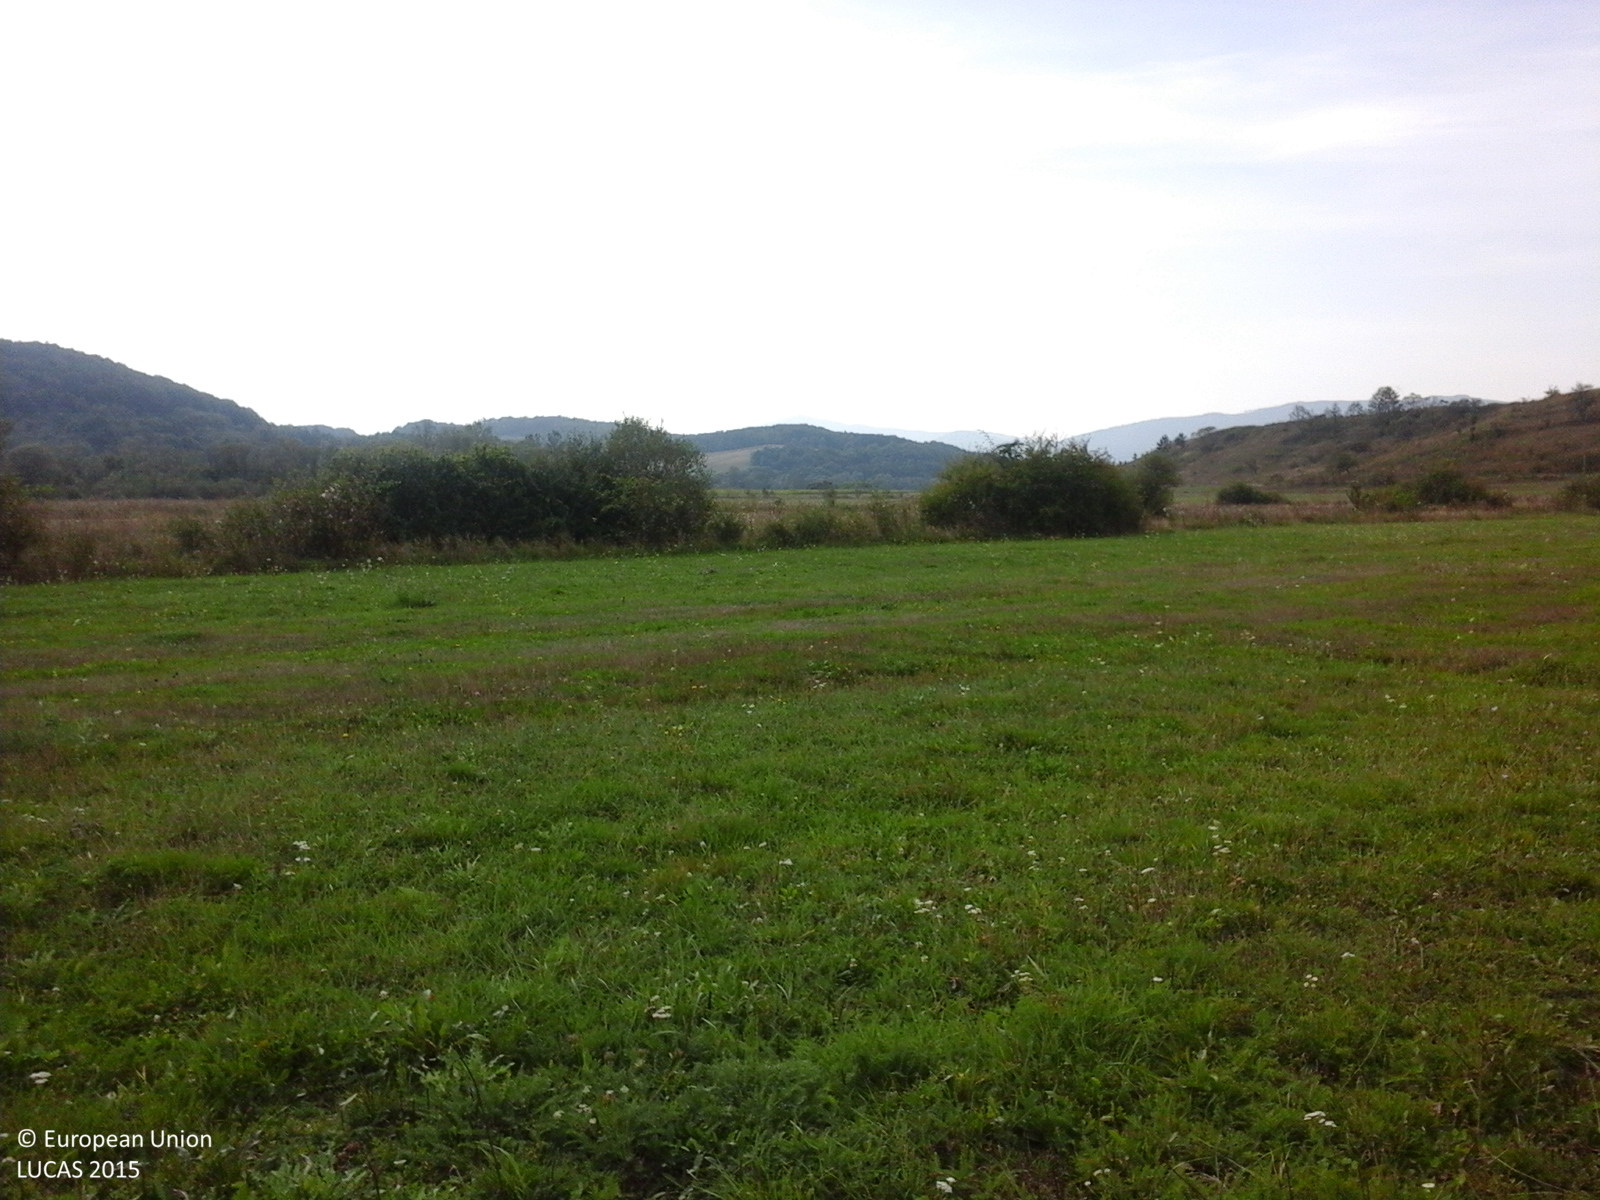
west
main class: Grassland
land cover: Grassland without tree/shrub cover
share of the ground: > 75 %
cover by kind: herbaceous plants 100 %
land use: Agriculture (excluding fallow land and kitchen gardens)
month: September
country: RO
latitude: 47.0246
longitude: 23.0493
